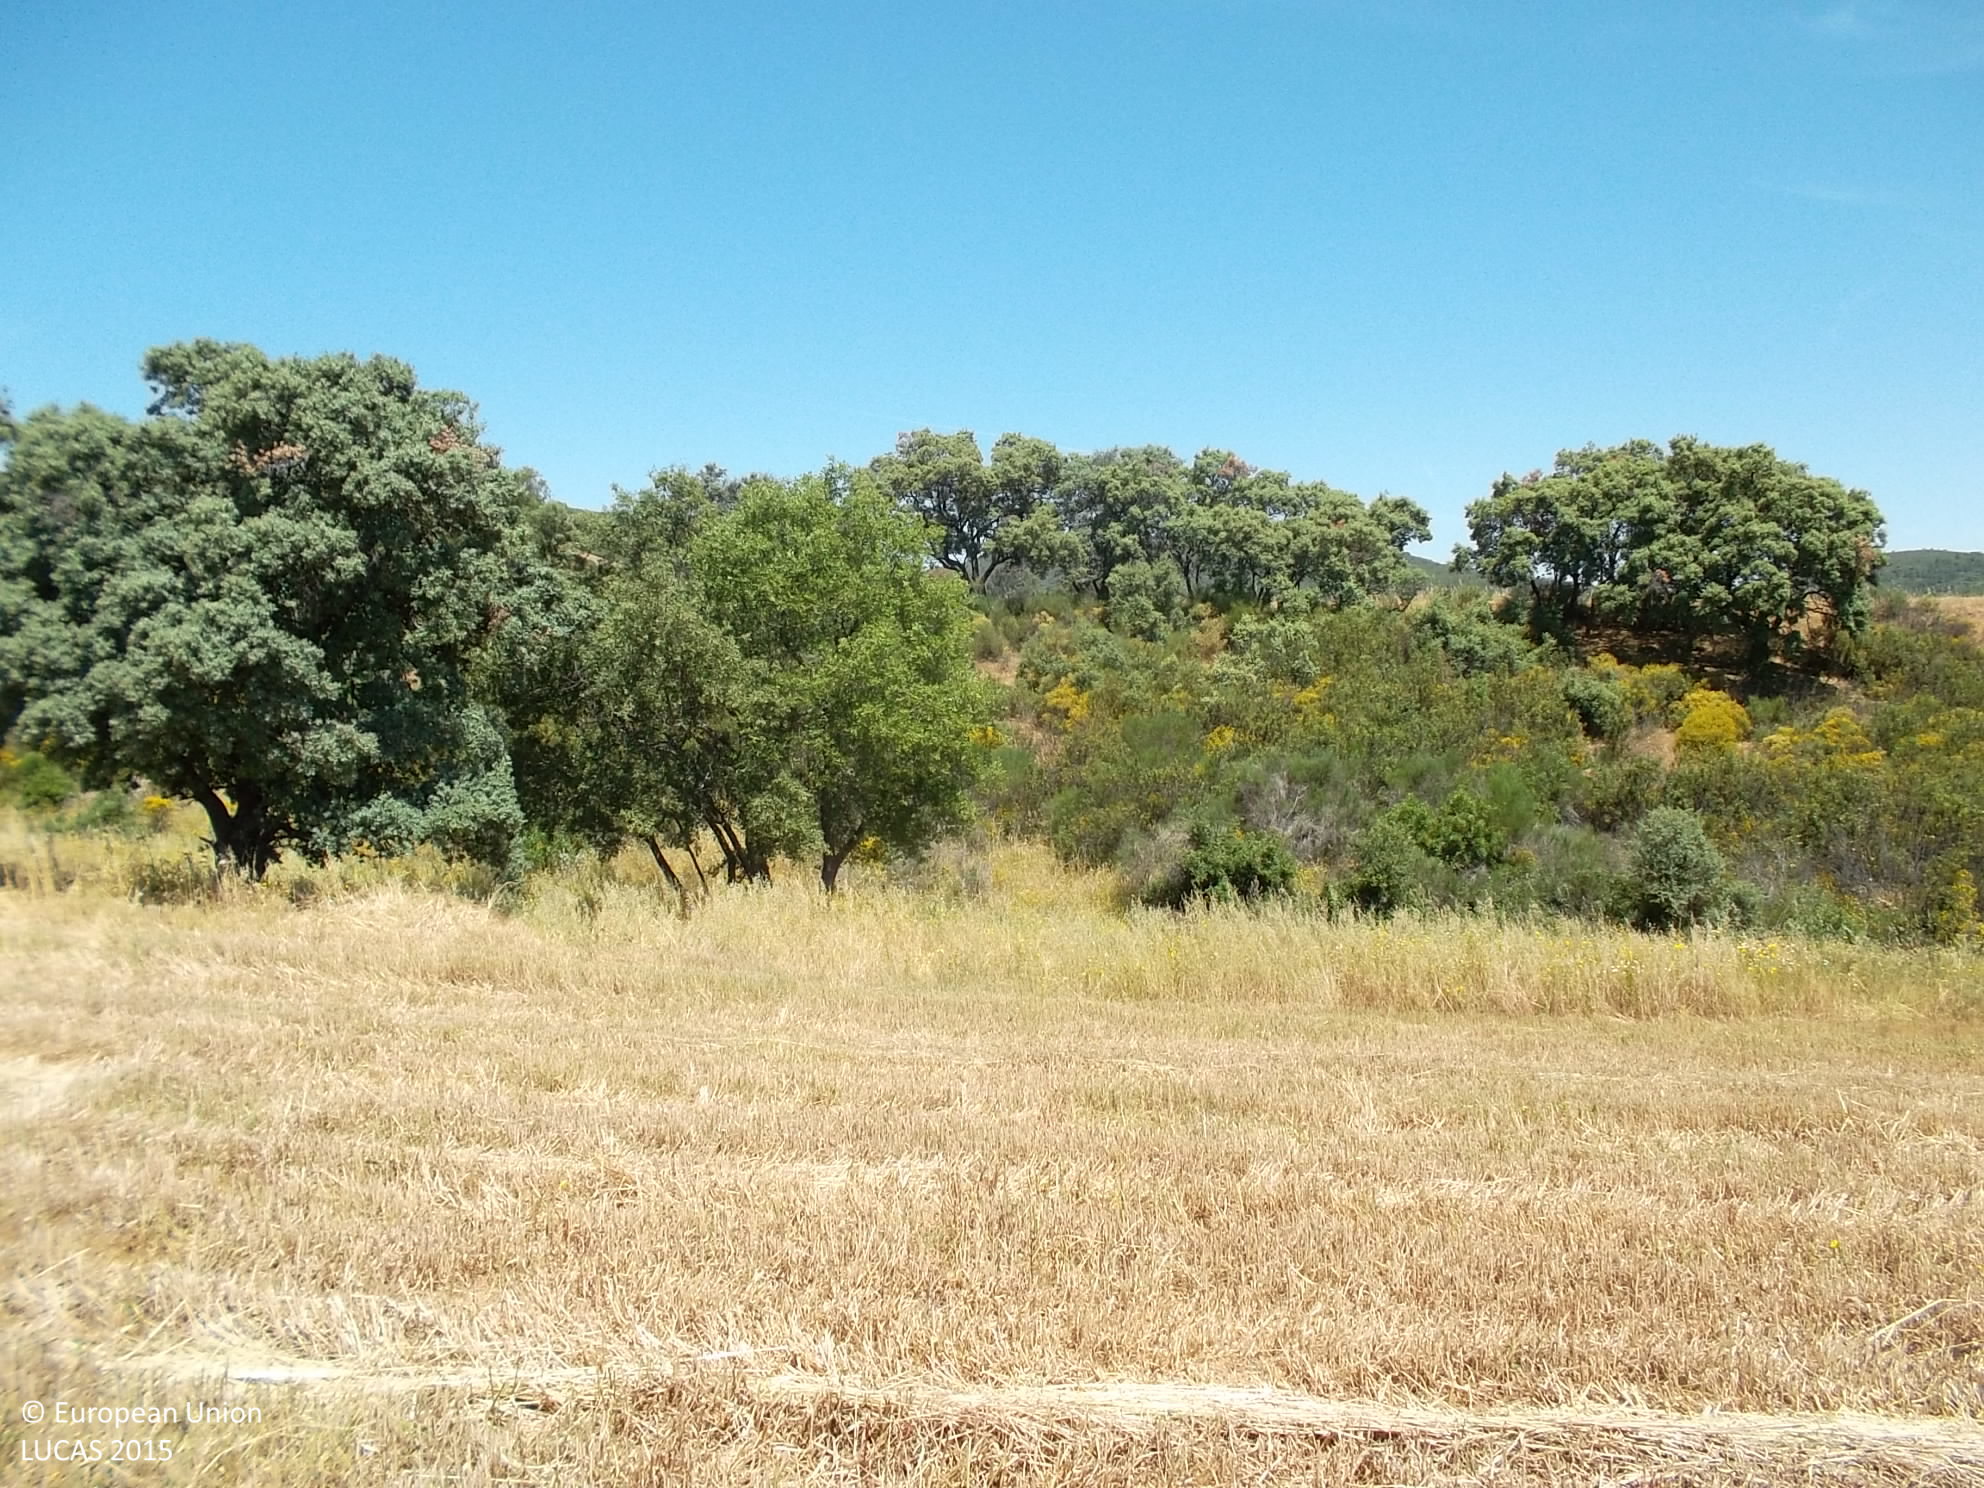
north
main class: Cropland
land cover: Oats
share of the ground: > 75 %
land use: Agriculture (excluding fallow land and kitchen gardens)
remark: Harvested field
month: May
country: ES
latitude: 38.9229
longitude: -4.5259
